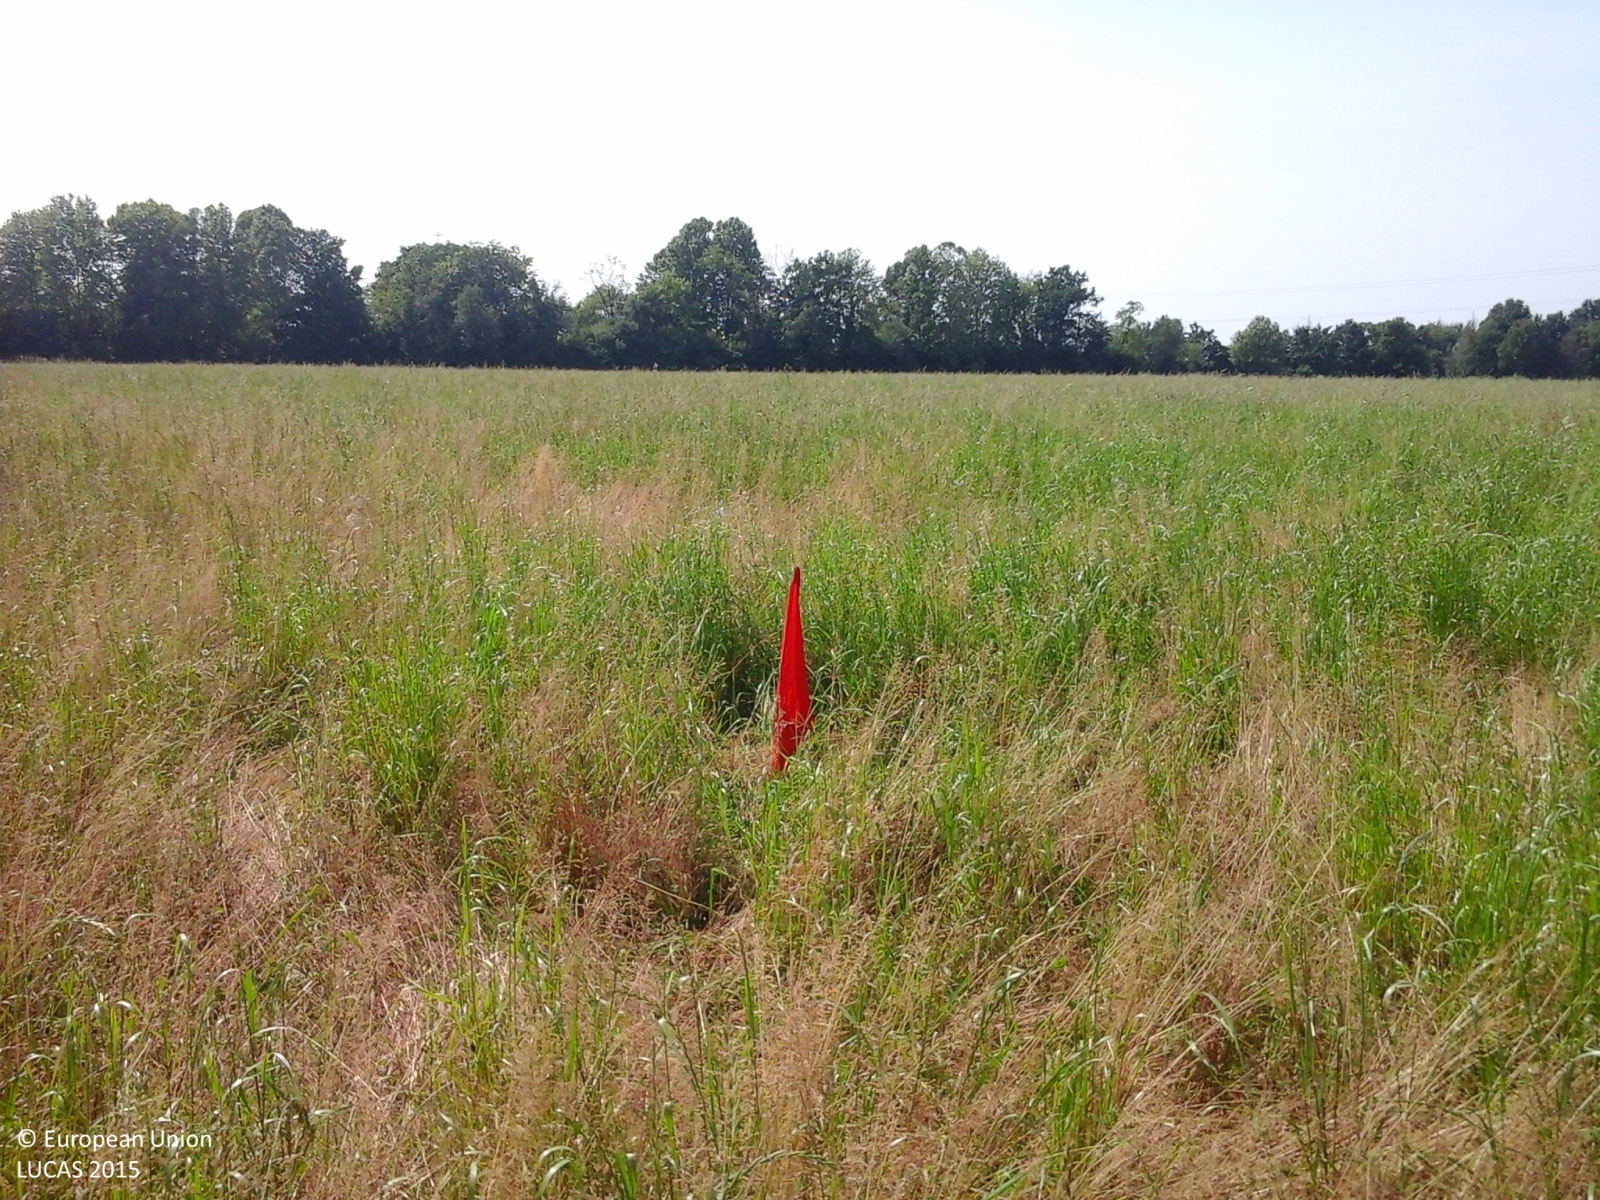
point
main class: Grassland
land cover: Spontaneously vegetated surfaces
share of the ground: > 75 %
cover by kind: herbaceous plants 100 %
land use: Agriculture (excluding fallow land and kitchen gardens)
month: May
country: IT
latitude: 45.4485
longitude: 9.3746
